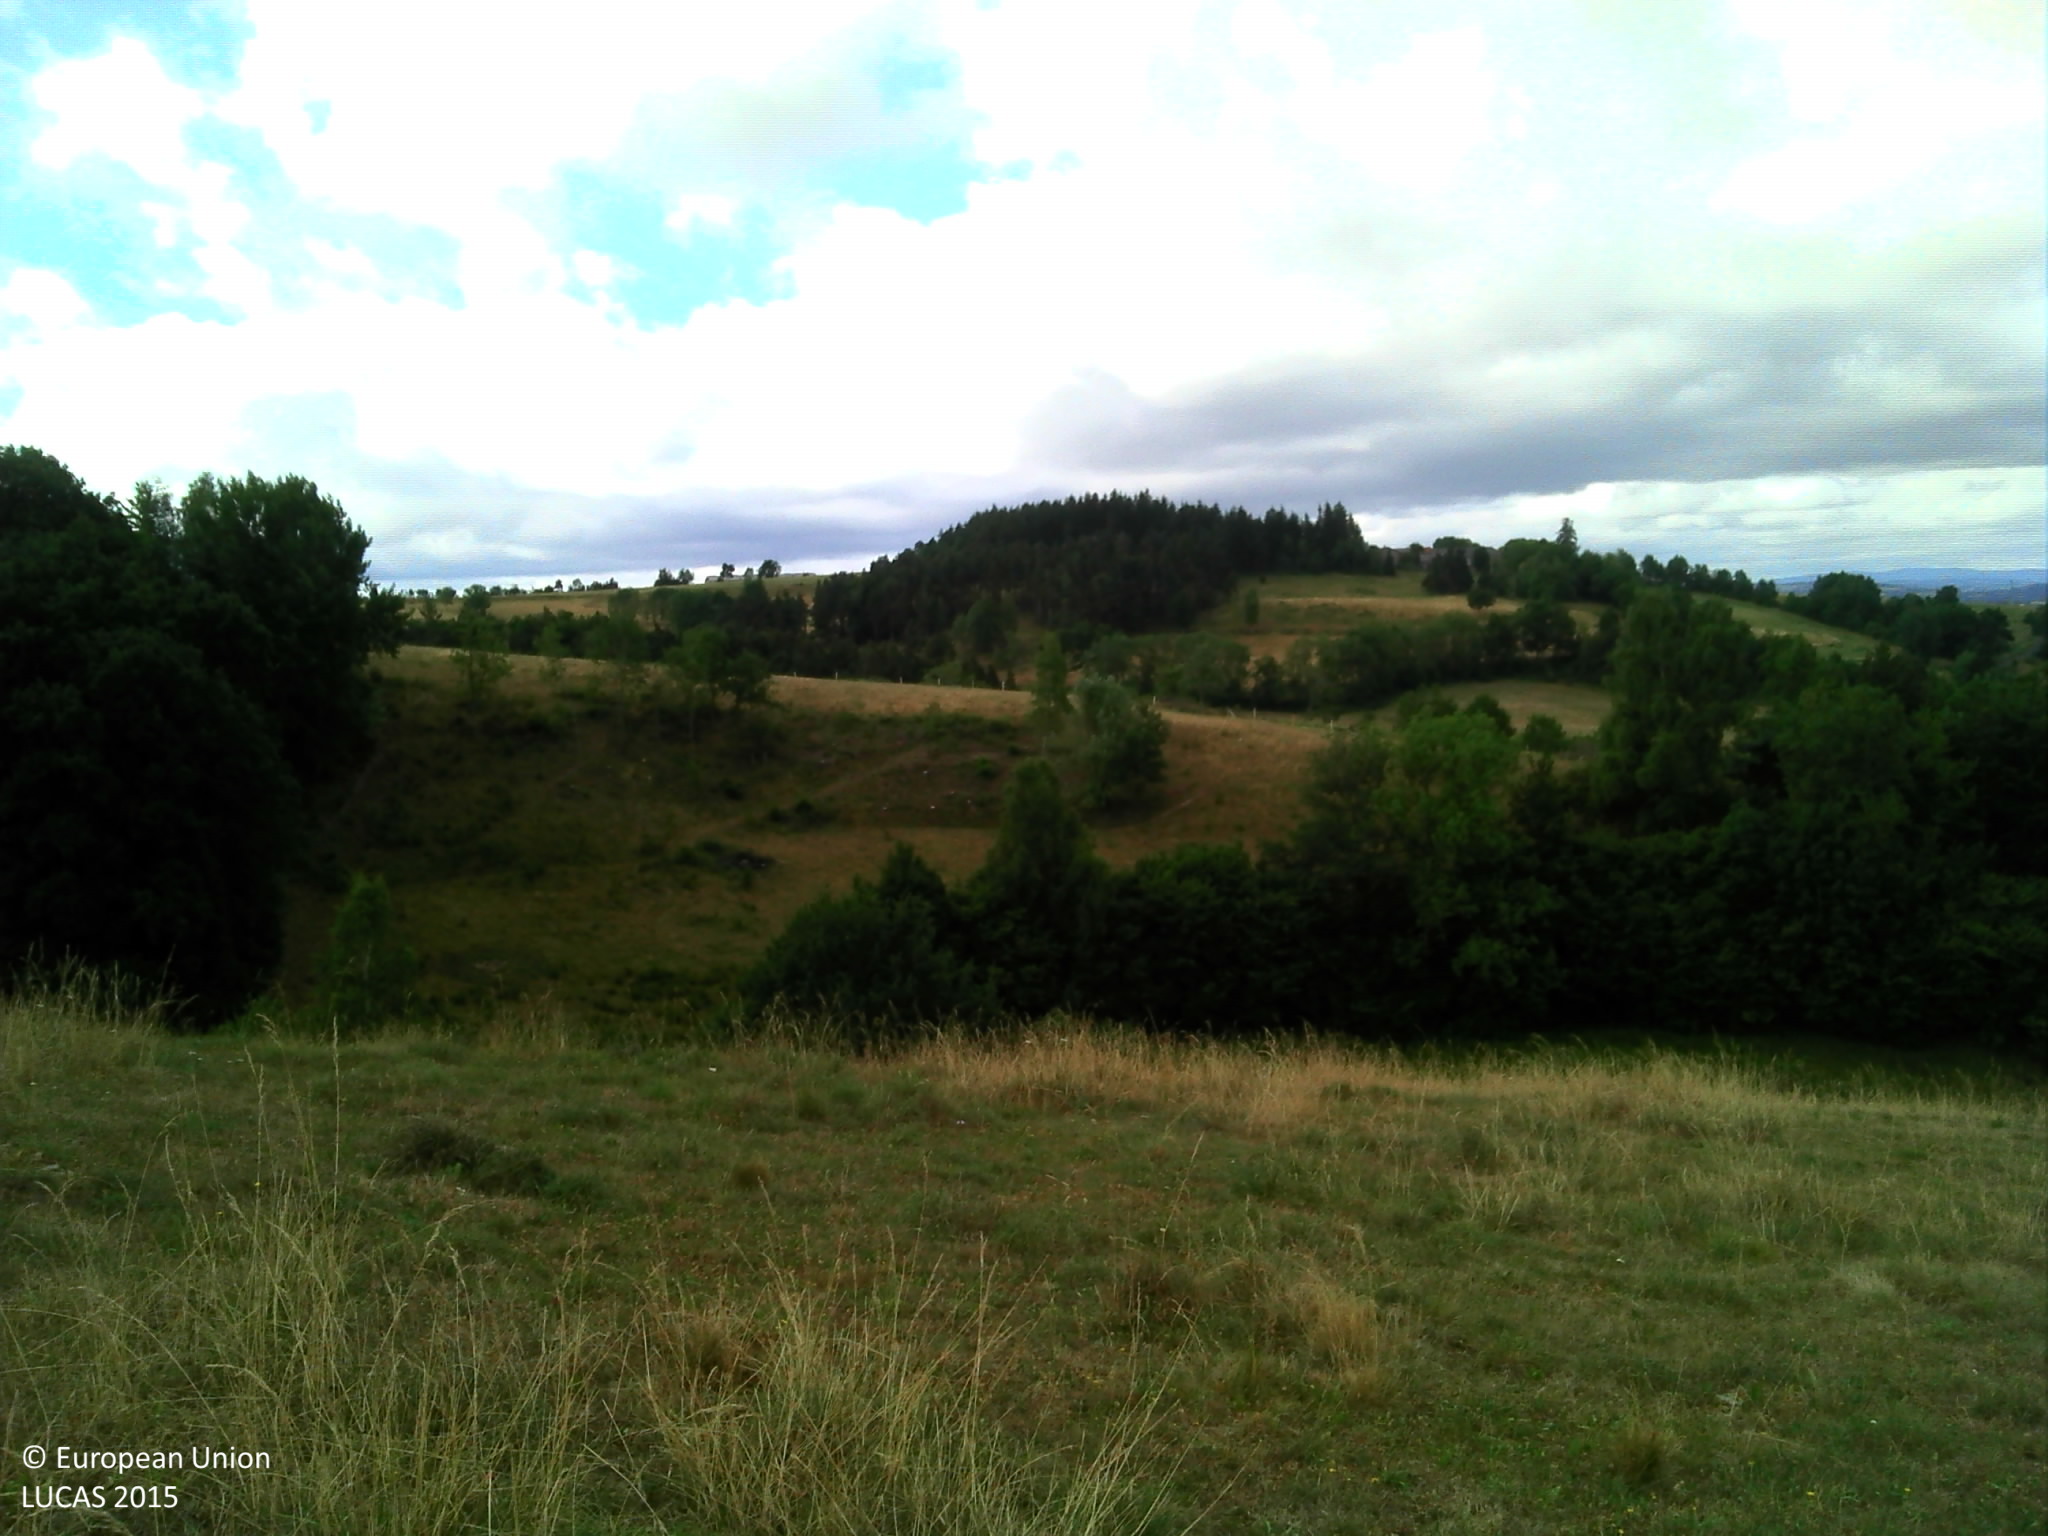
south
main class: Grassland
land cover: Grassland without tree/shrub cover
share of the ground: > 75 %
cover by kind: herbaceous plants 100 %
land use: Agriculture (excluding fallow land and kitchen gardens)
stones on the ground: < 10 %
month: July
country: FR
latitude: 45.0327
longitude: 3.2118
